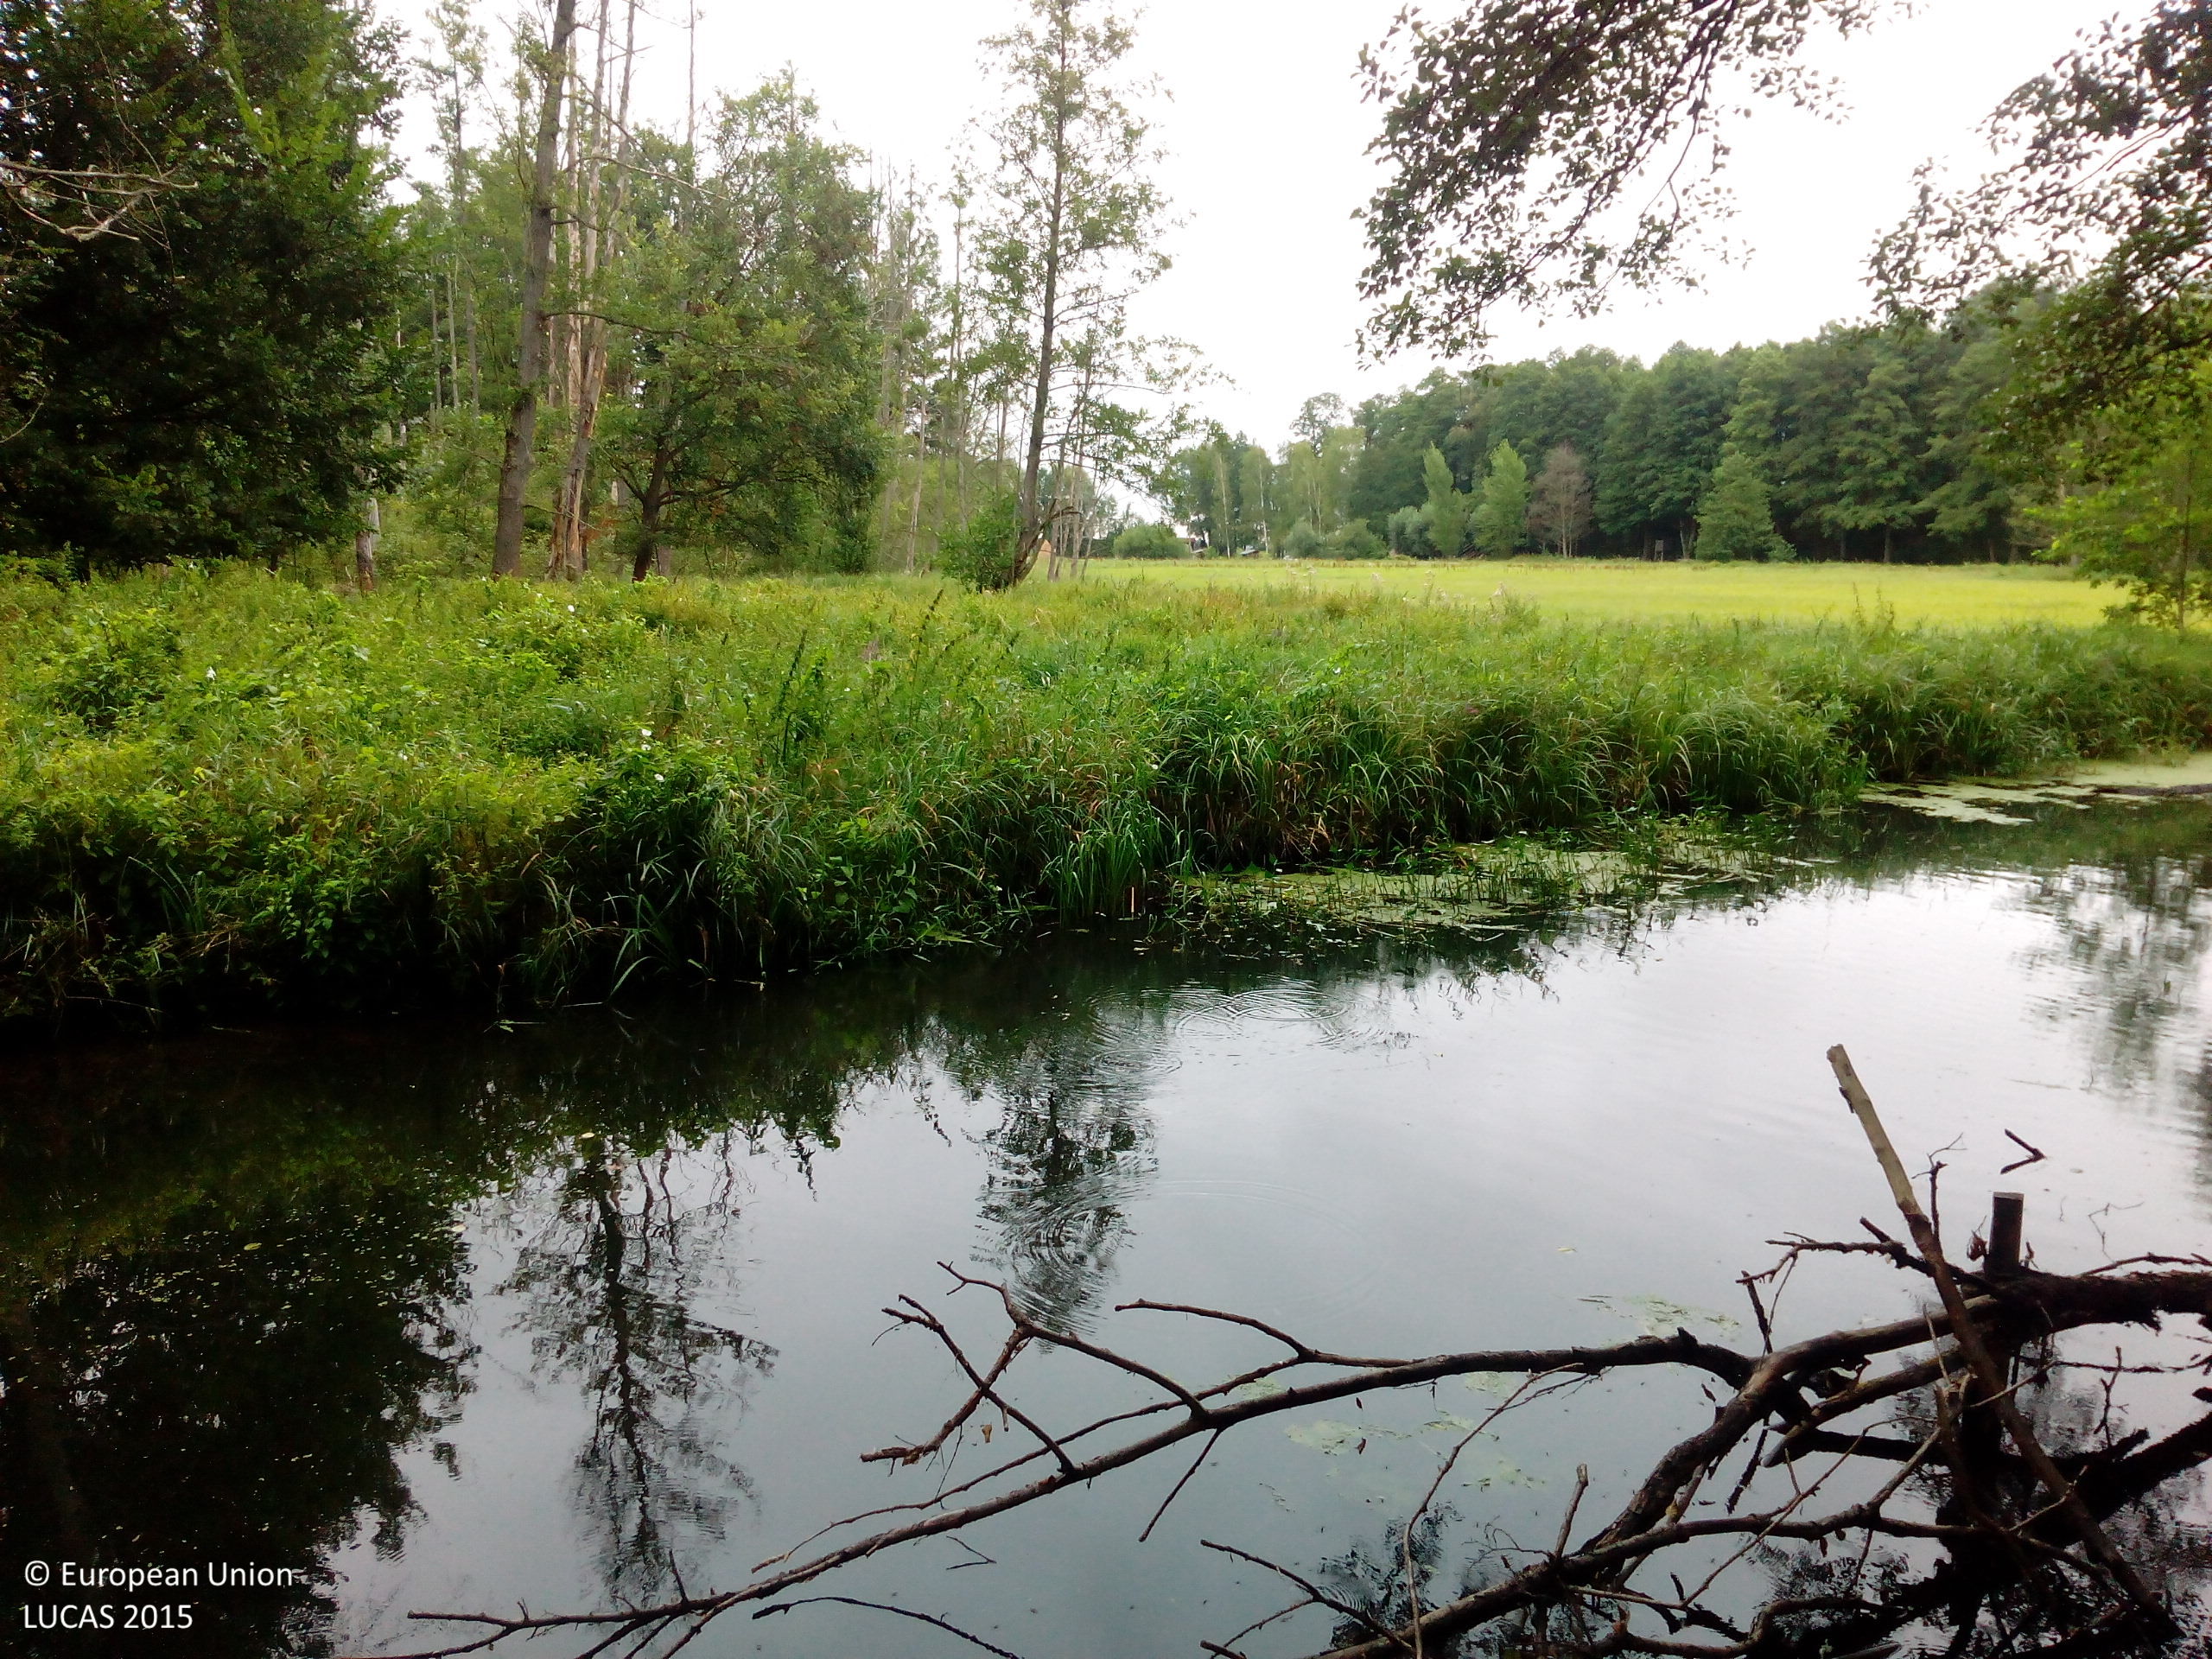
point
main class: Grassland
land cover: Grassland with sparse tree/shrub cover
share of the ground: > 75 %
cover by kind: herbaceous plants 95 %, broadleaved forest trees 5 %
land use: Agriculture (excluding fallow land and kitchen gardens)
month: August
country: DE
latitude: 51.8943
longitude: 14.0553
